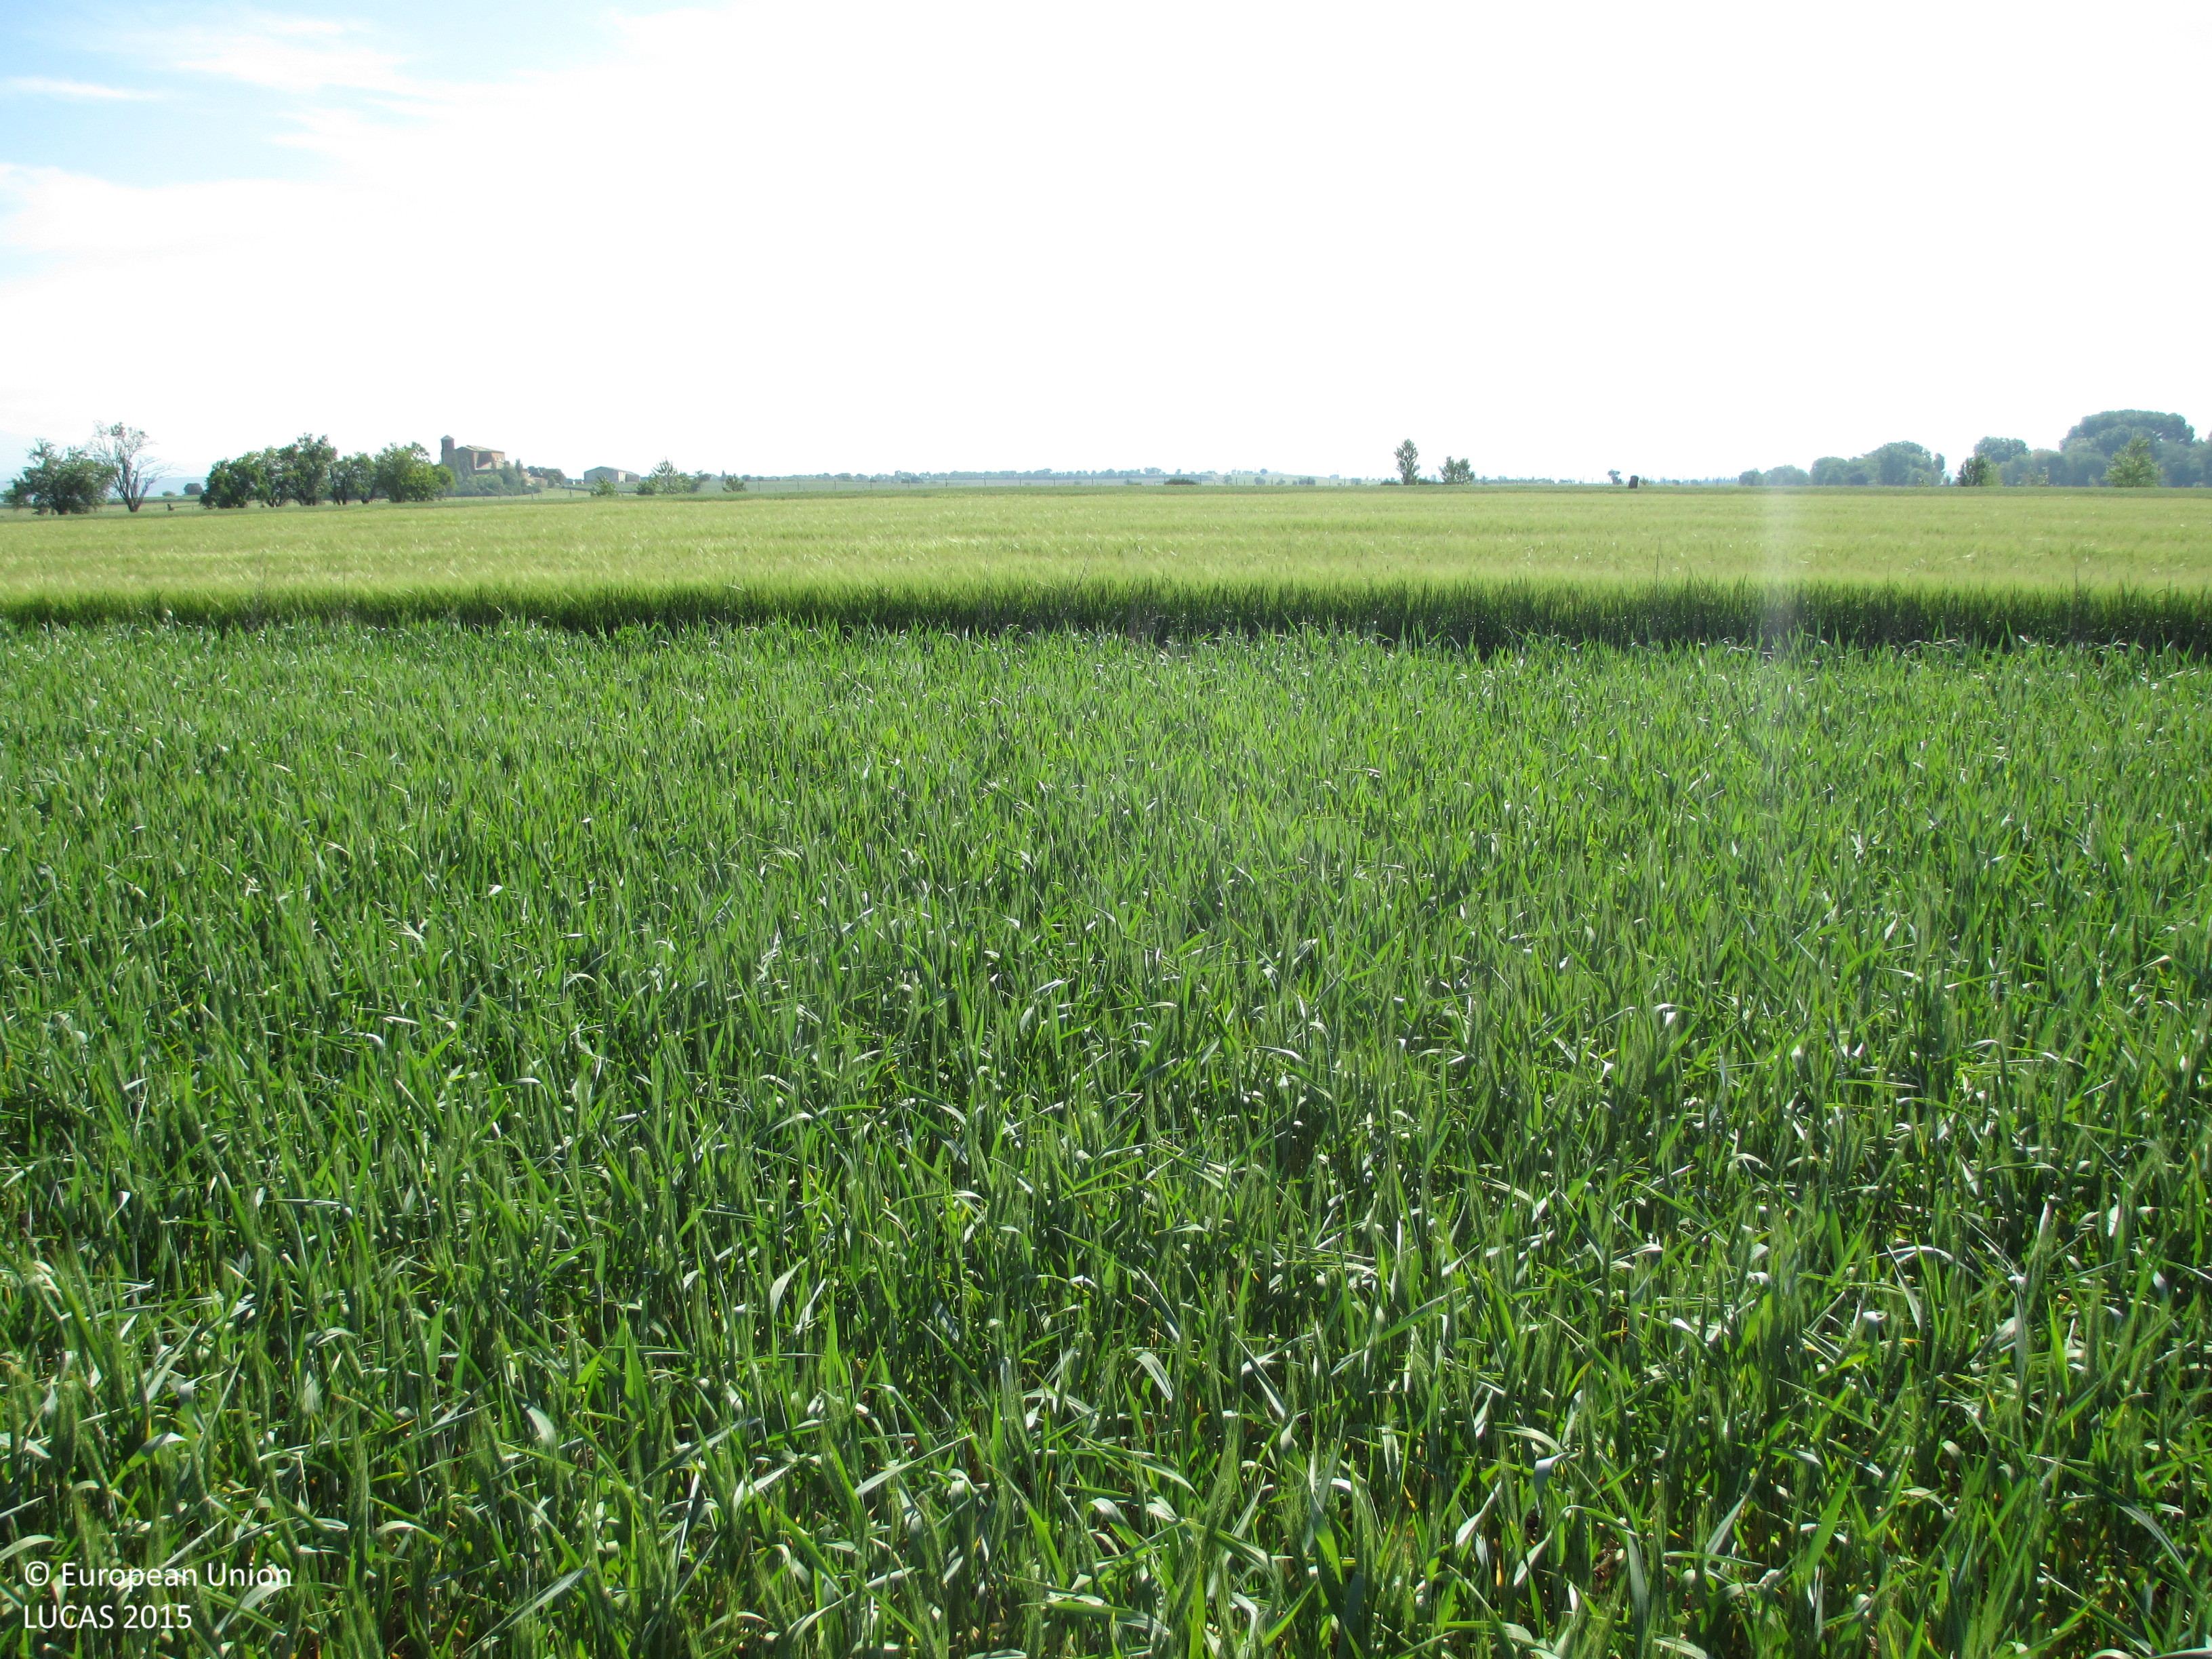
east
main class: Cropland
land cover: Durum wheat
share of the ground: > 75 %
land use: Agriculture (excluding fallow land and kitchen gardens)
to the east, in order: Durum wheat; Grass margins; Barley; Durum wheat; Grass margins; Fences; Grass margins; Single bushes/trees; Tracks; Grass margins; Railways; Grass margins; Fences; Durum wheat
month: April
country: ES
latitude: 42.1289
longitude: -0.4628
